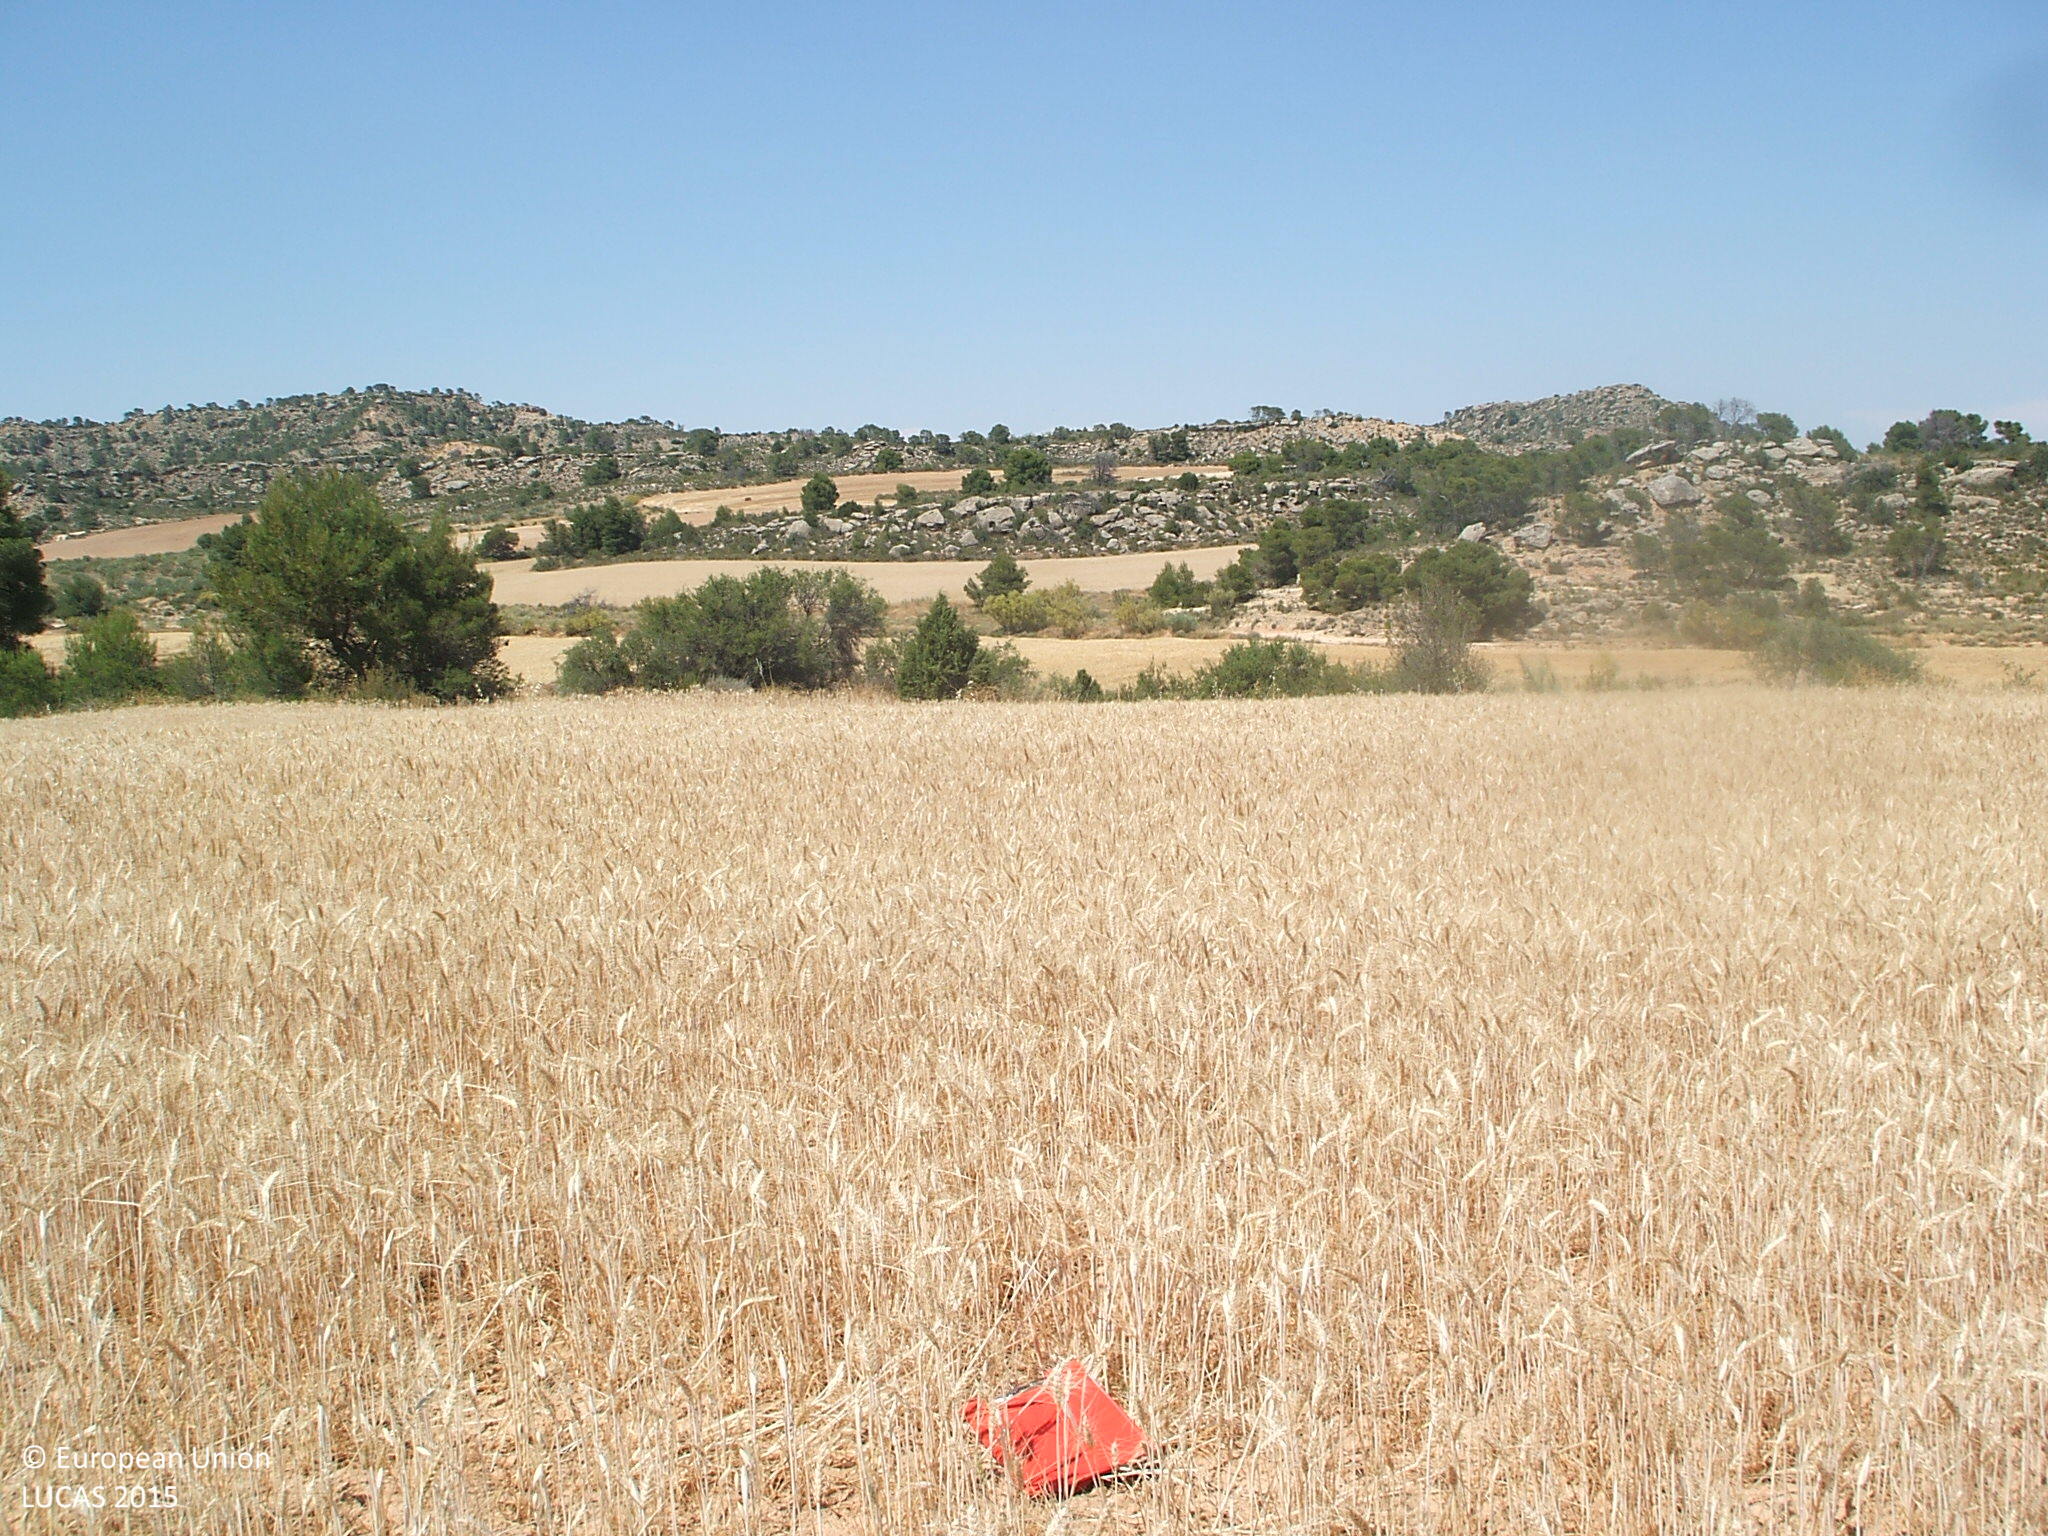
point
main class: Cropland
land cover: Common wheat
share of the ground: > 75 %
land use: Agriculture (excluding fallow land and kitchen gardens)
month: June
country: ES
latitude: 41.0955
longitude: -0.0718
